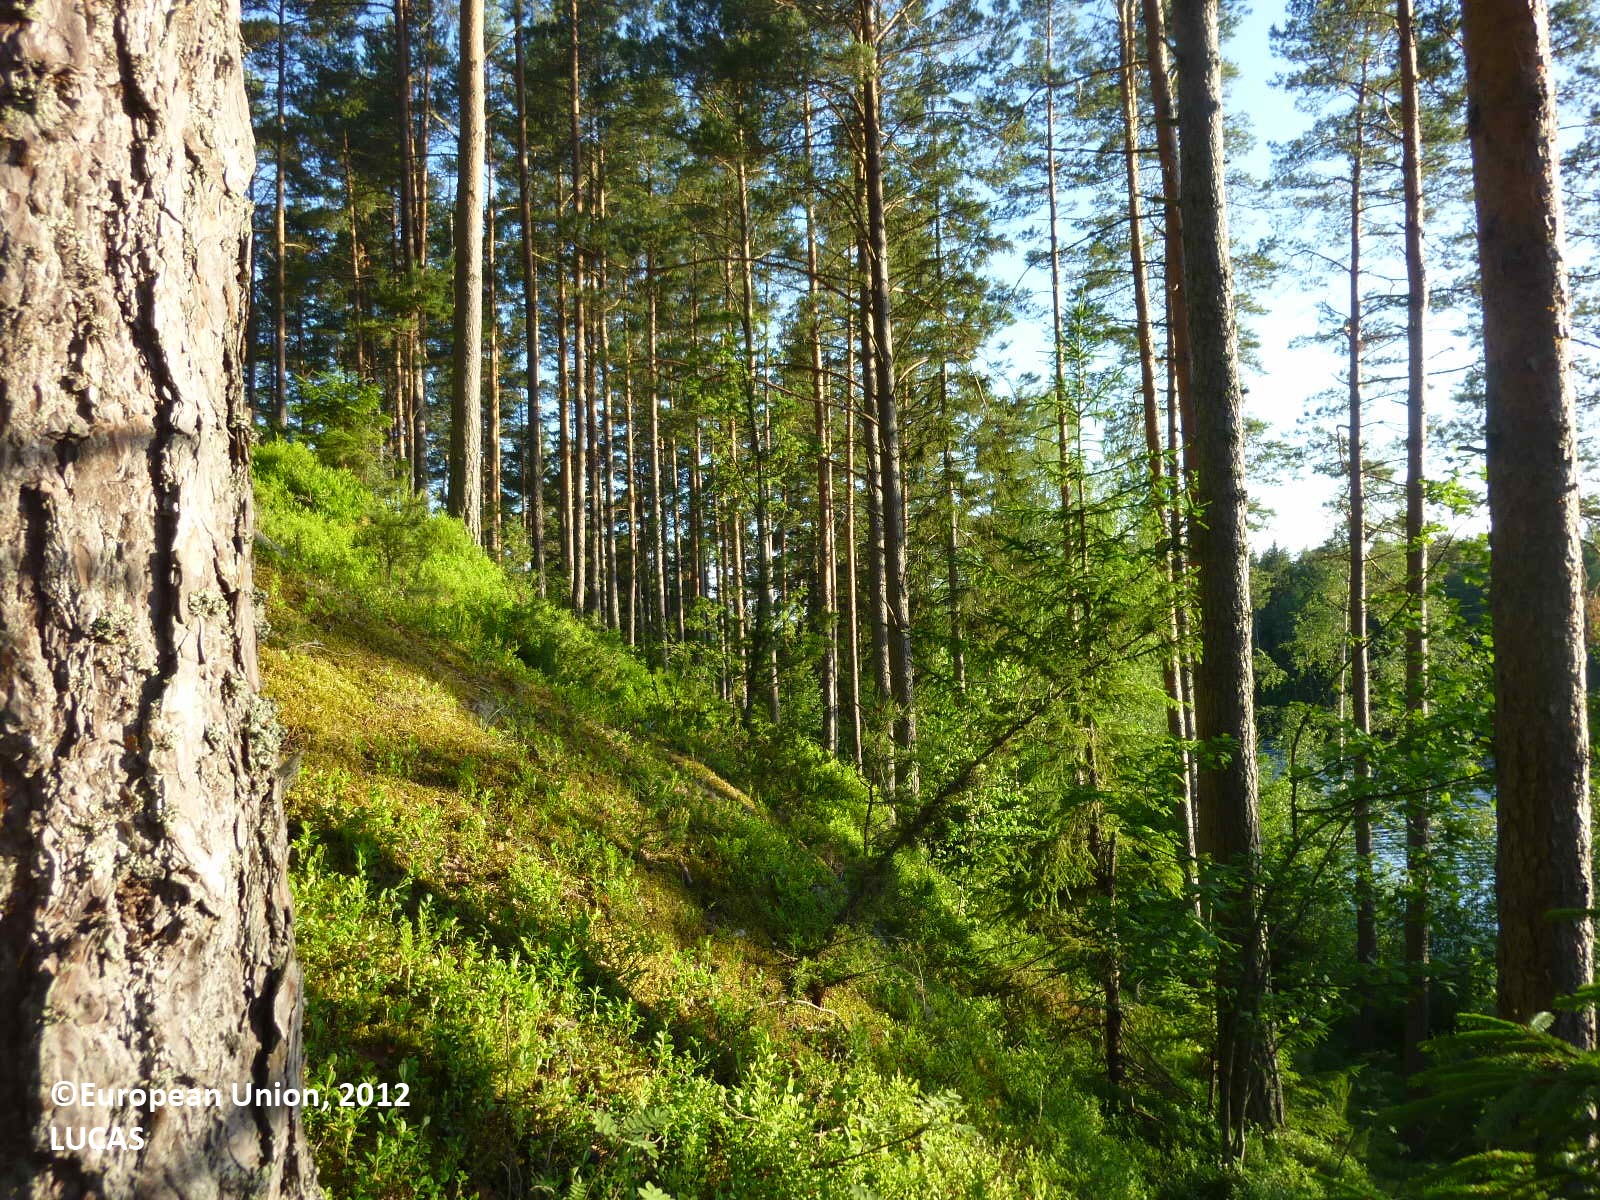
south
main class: Woodland
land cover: Pine dominated coniferous woodland
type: boreal forest
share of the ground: 50 - 75 %
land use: Forestry
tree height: > 5 m
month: June
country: FI
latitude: 60.0500
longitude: 22.4083
